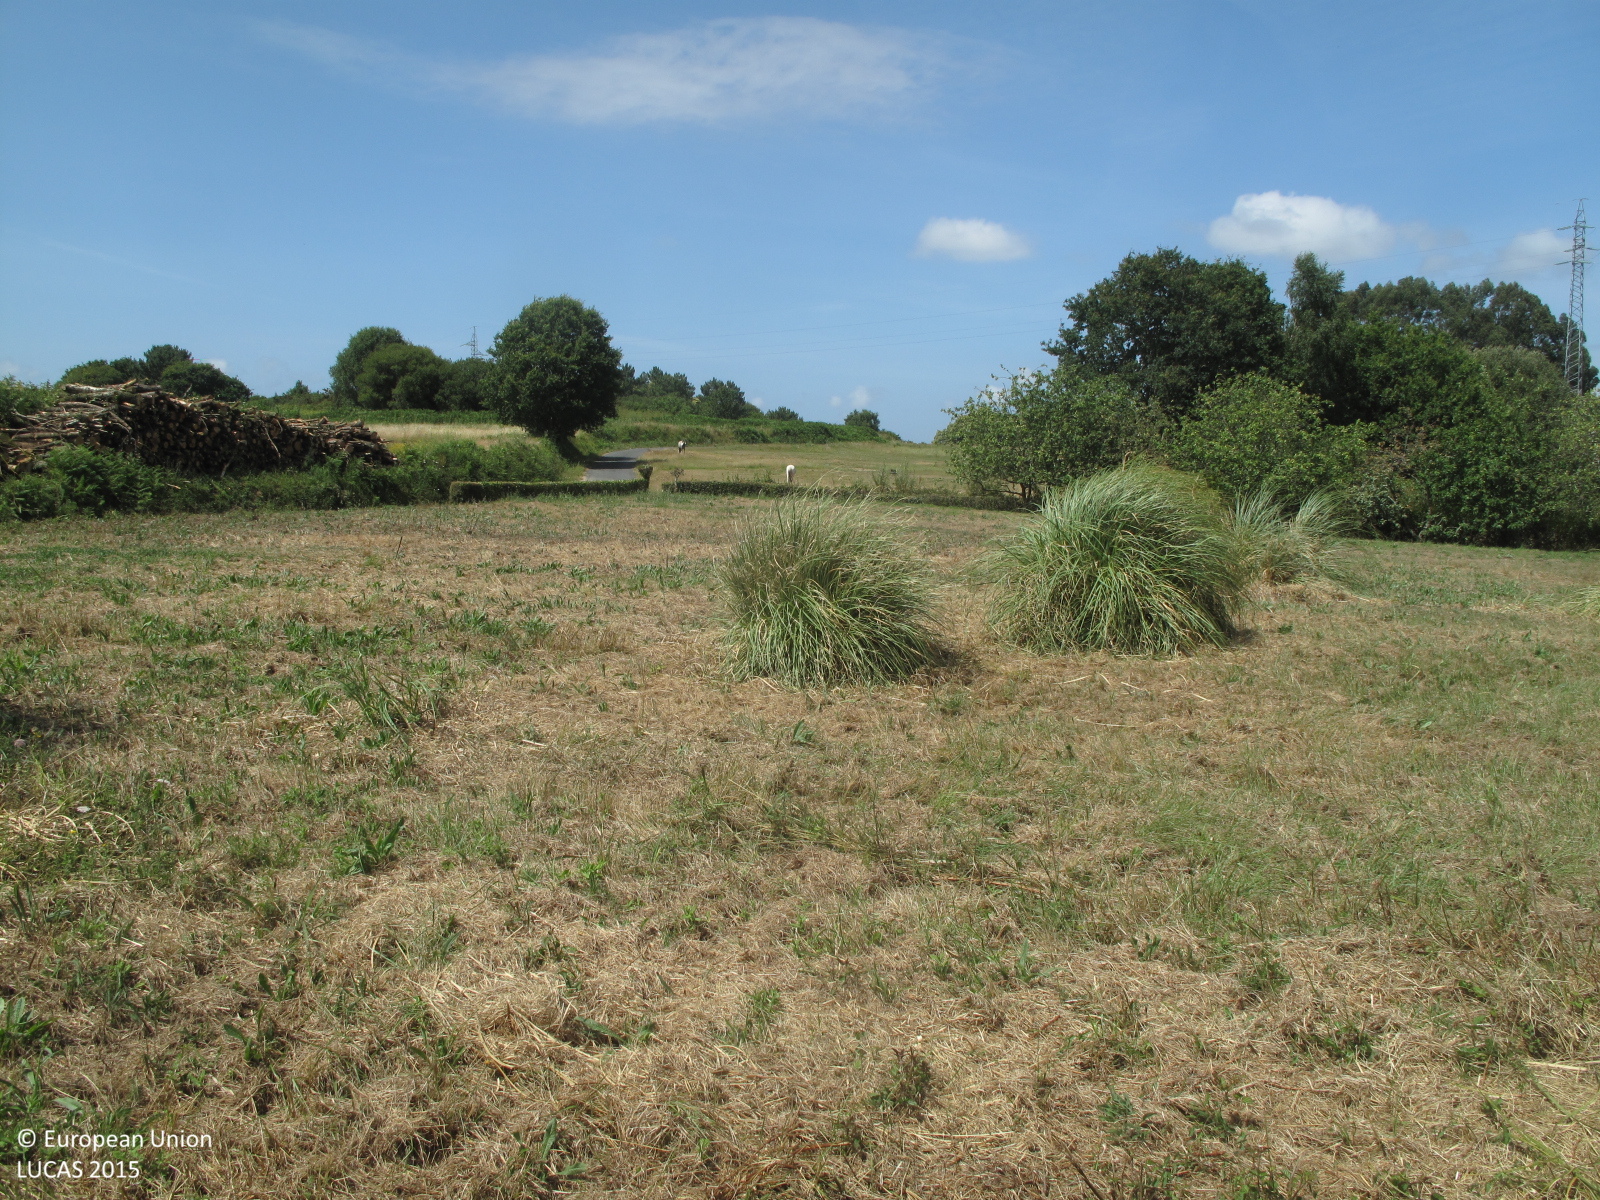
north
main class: Shrubland
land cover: Shrubland without tree cover
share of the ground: 25 - 50 %
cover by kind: herbaceous plants 70 %, shrubs 30 %
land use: Abandoned areas
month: July
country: ES
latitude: 43.4435
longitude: -8.2030
